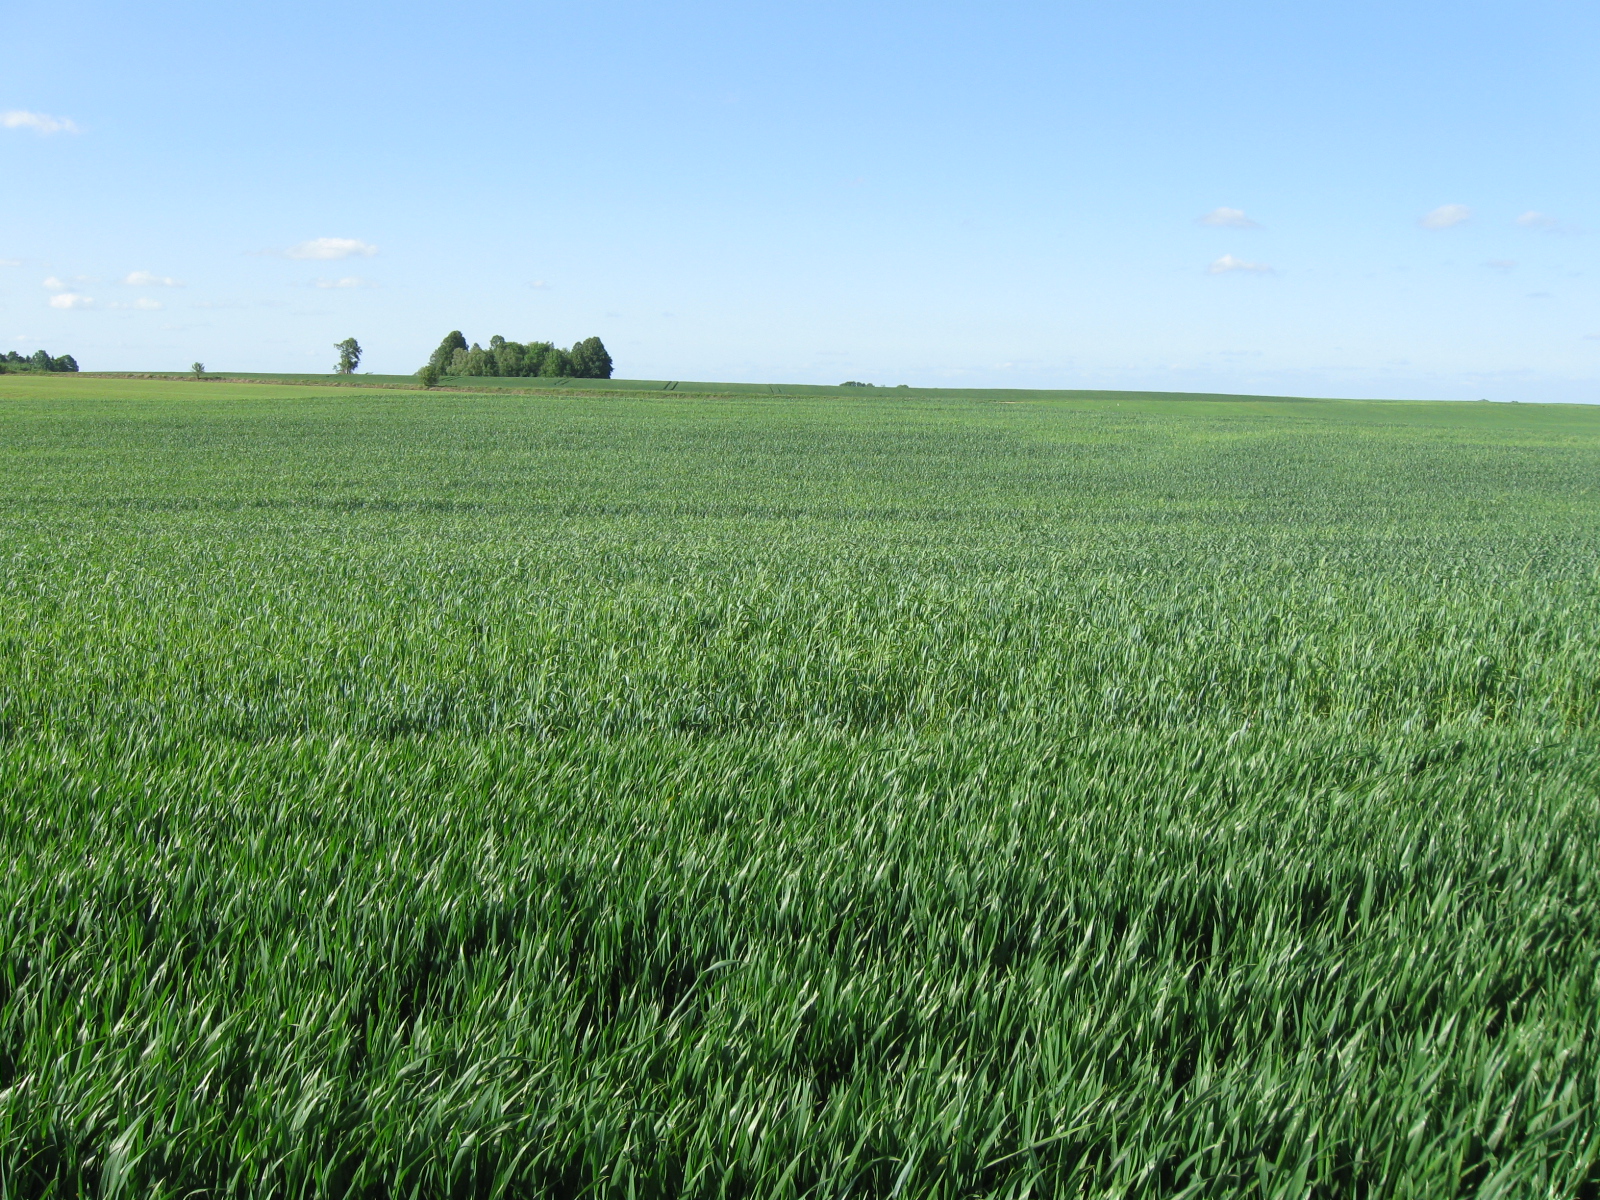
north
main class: Cropland
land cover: Common wheat
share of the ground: > 75 %
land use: Agriculture (excluding fallow land and kitchen gardens)
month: June
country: LT
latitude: 54.4577
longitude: 23.7383
